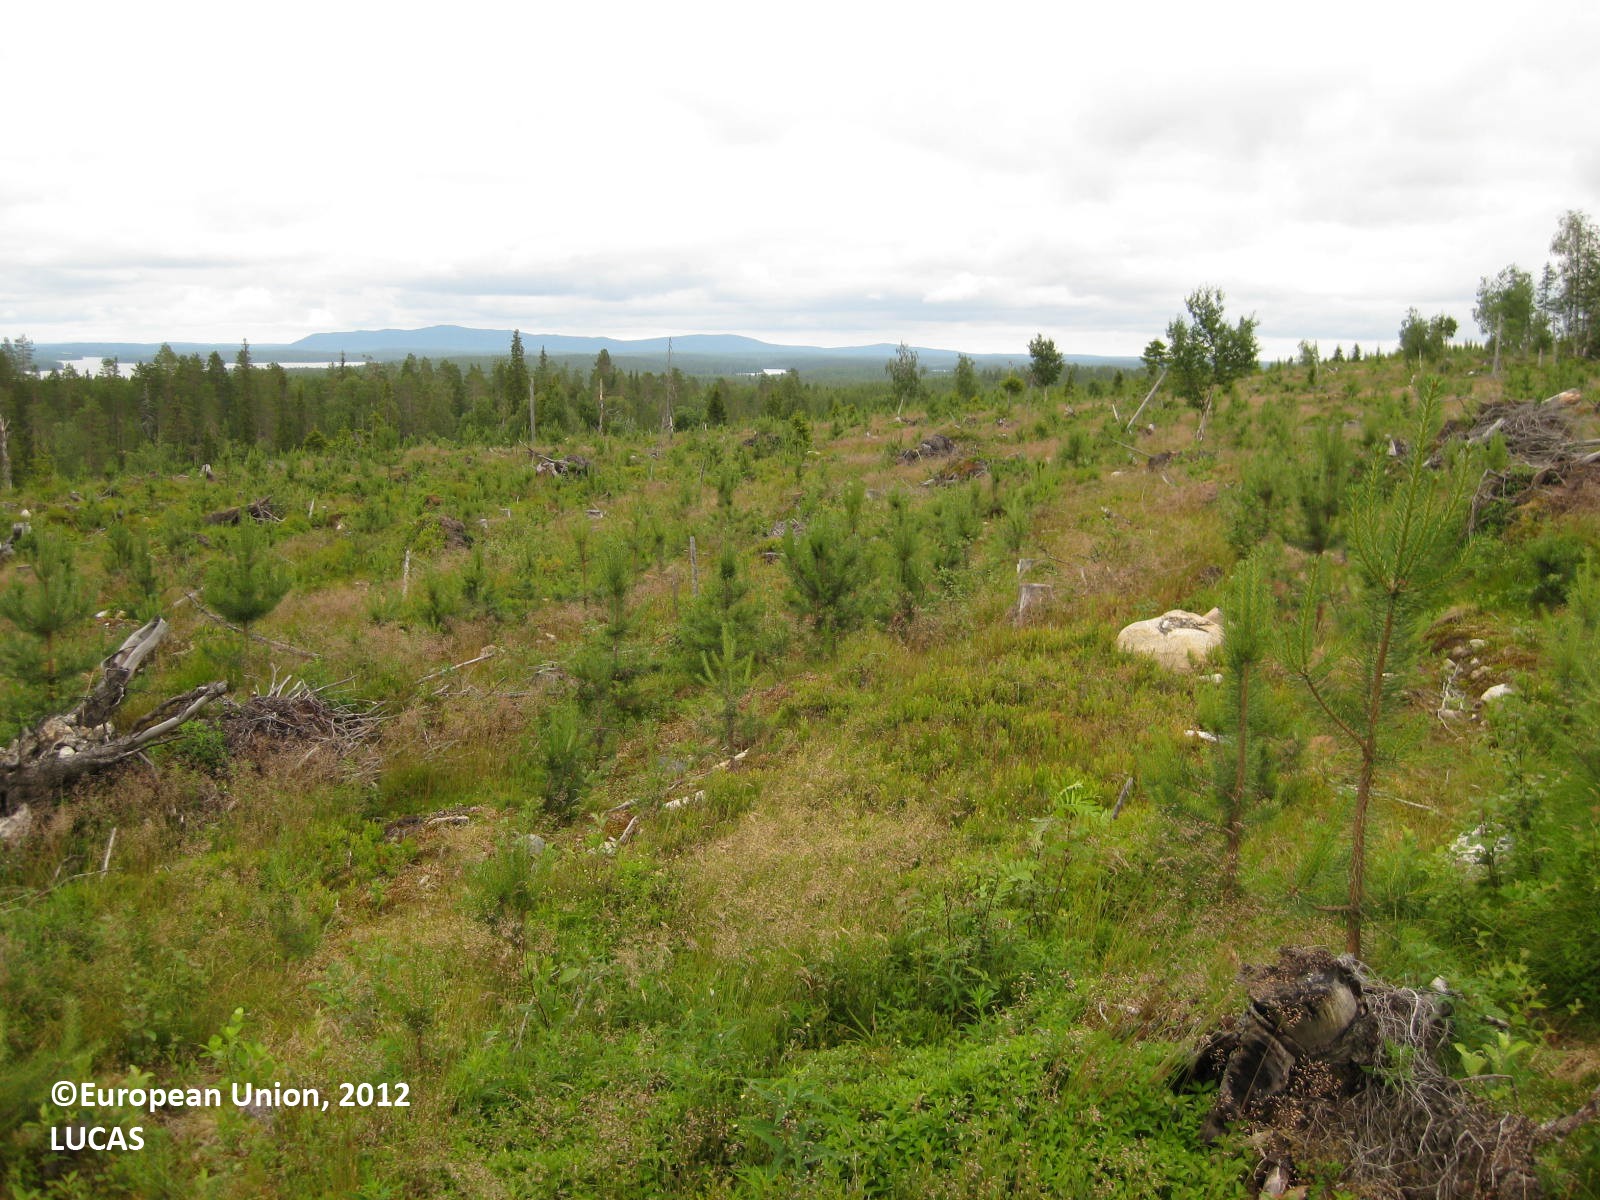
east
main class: Woodland
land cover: Pine dominated coniferous woodland
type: boreal forest
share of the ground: 10 - 25 %
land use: Forestry
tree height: < 5 m
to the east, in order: Pine dominated coniferous woodland; Ditches and canals; Pine dominated coniferous woodland; Ditches and canals; Pine dominated coniferous woodland; Ditches and canals; Pine dominated coniferous woodland; Ditches and canals; Pine dominated coniferous woodland; Ditches and canals; Pine dominated coniferous woodland; Ditches and canals; Pine dominated coniferous woodland; Ditches and canals; Pine dominated coniferous woodland; Spruce dominated mixed woodland; Peatbogs
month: July
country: FI
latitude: 65.8107
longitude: 29.3696
